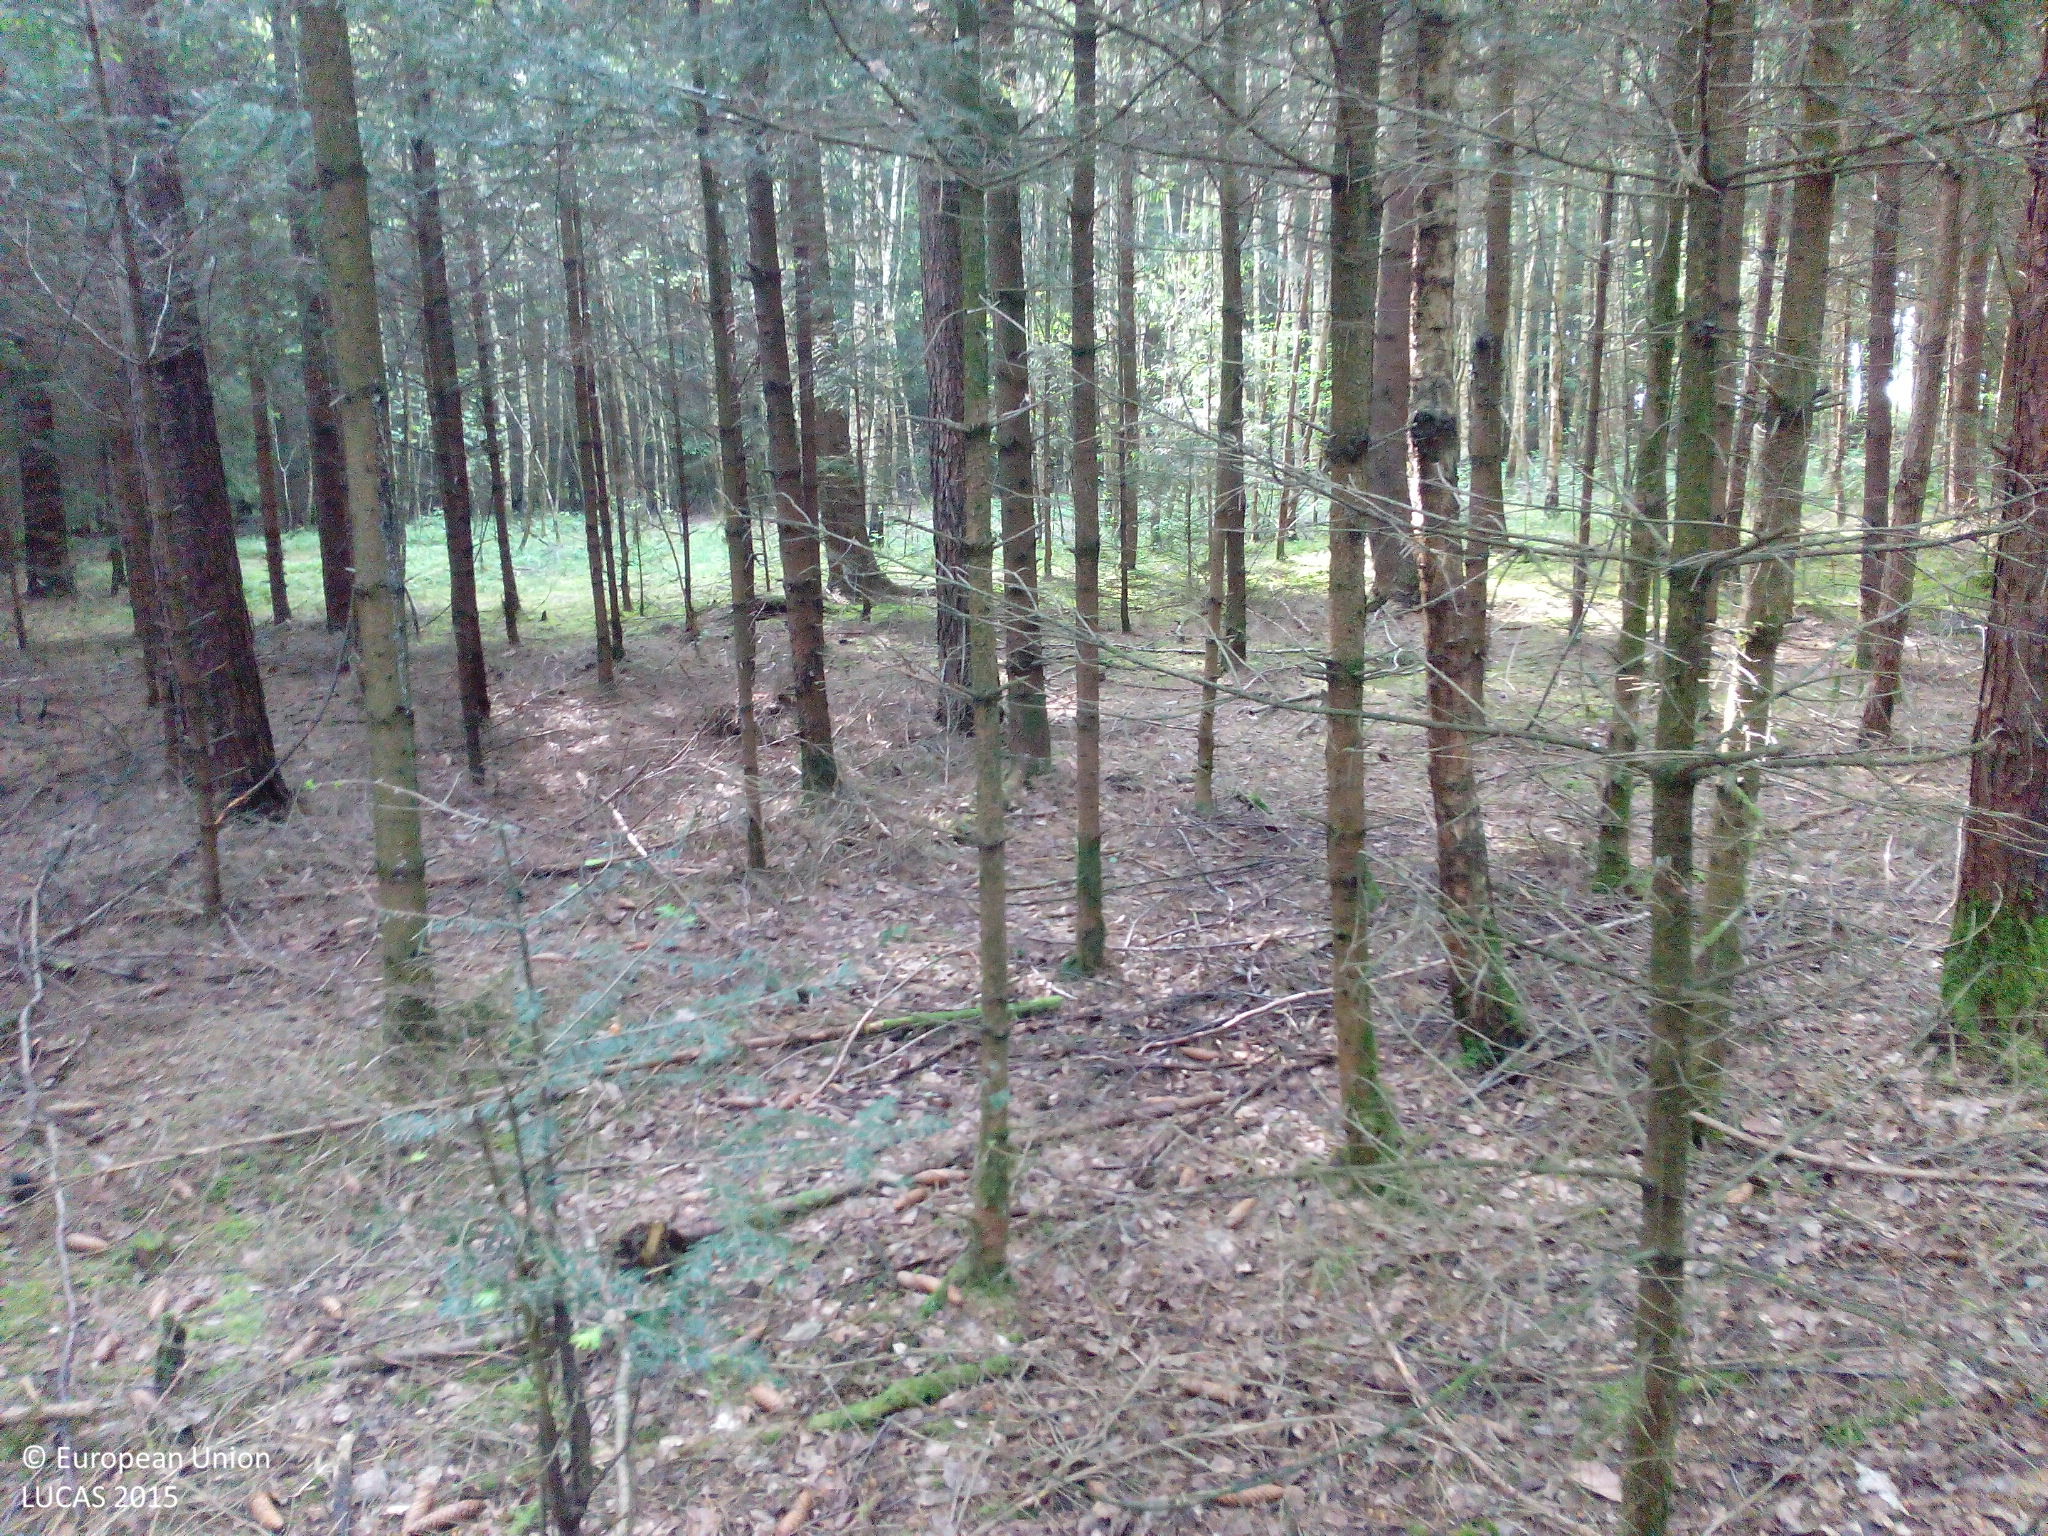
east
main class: Woodland
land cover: Spruce dominated coniferous woodland
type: hemiboreal forest and nemoral coniferous forest and mixed broadleaved-coniferous forest
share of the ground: > 75 %
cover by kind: coniferous forest trees 90 %, broadleaved forest trees 10 %
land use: Forestry
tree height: > 5 m
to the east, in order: Spruce dominated coniferous woodland; Pine dominated coniferous woodland; Spruce dominated coniferous woodland; Pine dominated mixed woodland; Spruce dominated coniferous woodland; Pine dominated mixed woodland; Grass margins; Pine dominated mixed woodland; Grass margins; Pine dominated mixed woodland; Grass margins; Paved roads, cycling and walking lanes; Grass margins; Ditches and canals; Grass margins; Barley
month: May
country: DE
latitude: 49.3376
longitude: 10.5640
